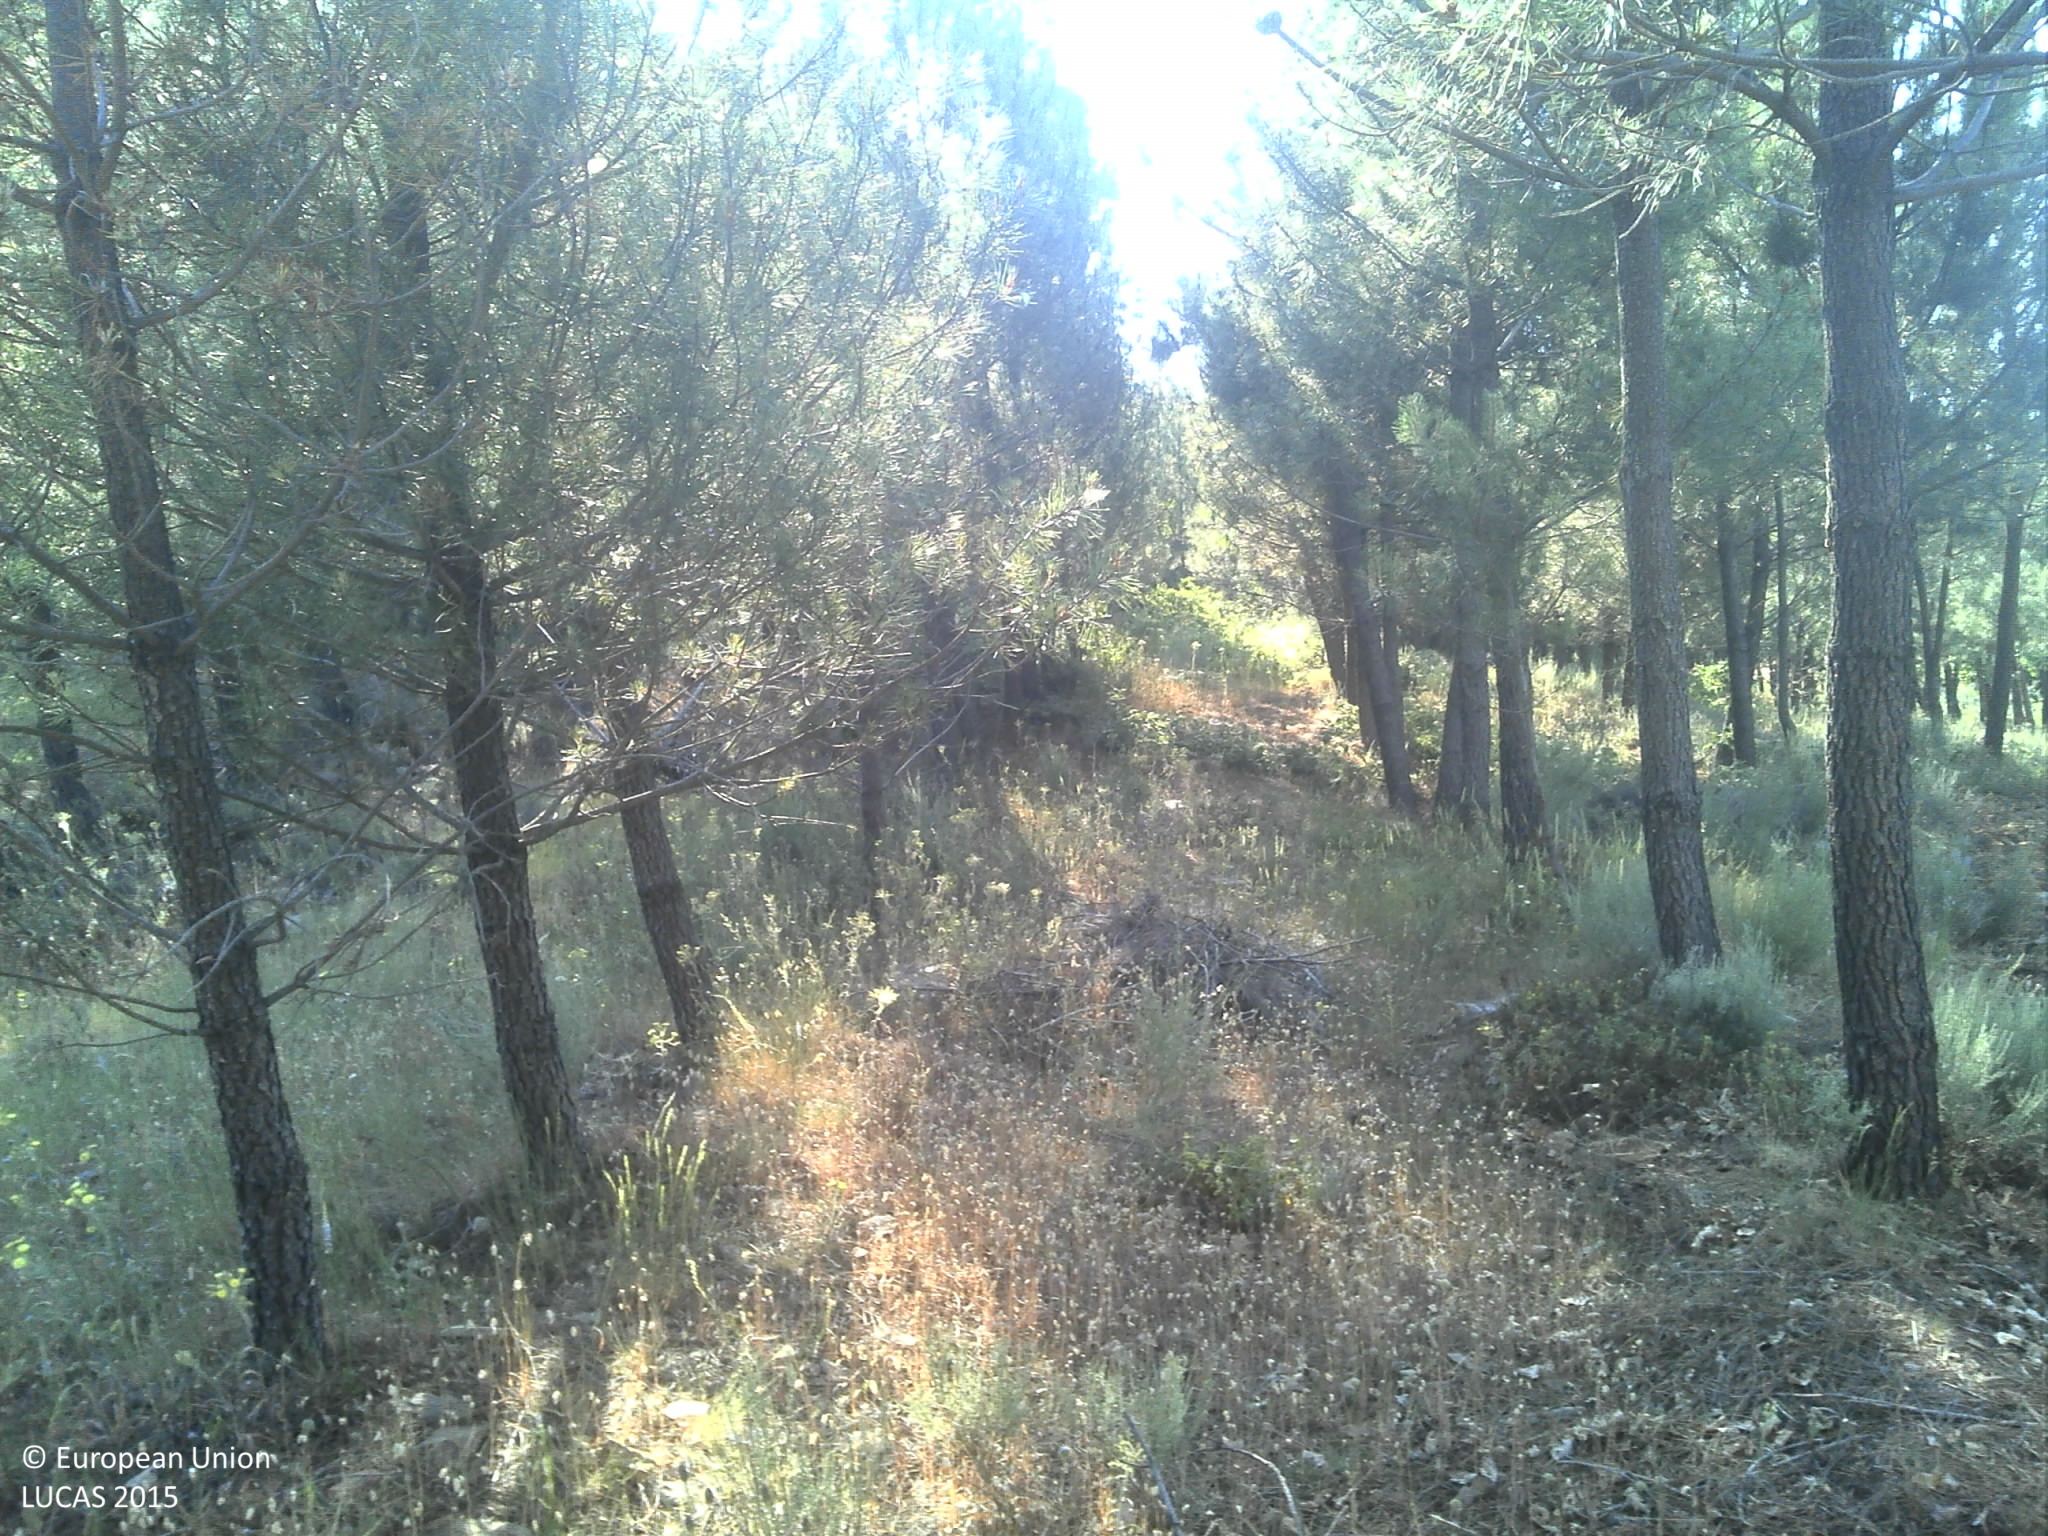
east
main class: Woodland
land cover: Pine dominated coniferous woodland
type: coniferous forest of the mediterranean region
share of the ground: 50 - 75 %
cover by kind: coniferous forest trees 65 %, unconsolidated bare surface 30 %, shrubs 5 %
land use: Forestry
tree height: > 5 m
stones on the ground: 10 - 25 %
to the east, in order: Pine dominated coniferous woodland; Tracks; Shruby margins; Tracks; Shrubland without tree cover; Pine dominated coniferous woodland; Shrubland without tree cover; Fences; Grassland without tree/shrub cover
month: June
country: PT
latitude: 40.3365
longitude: -7.0117
